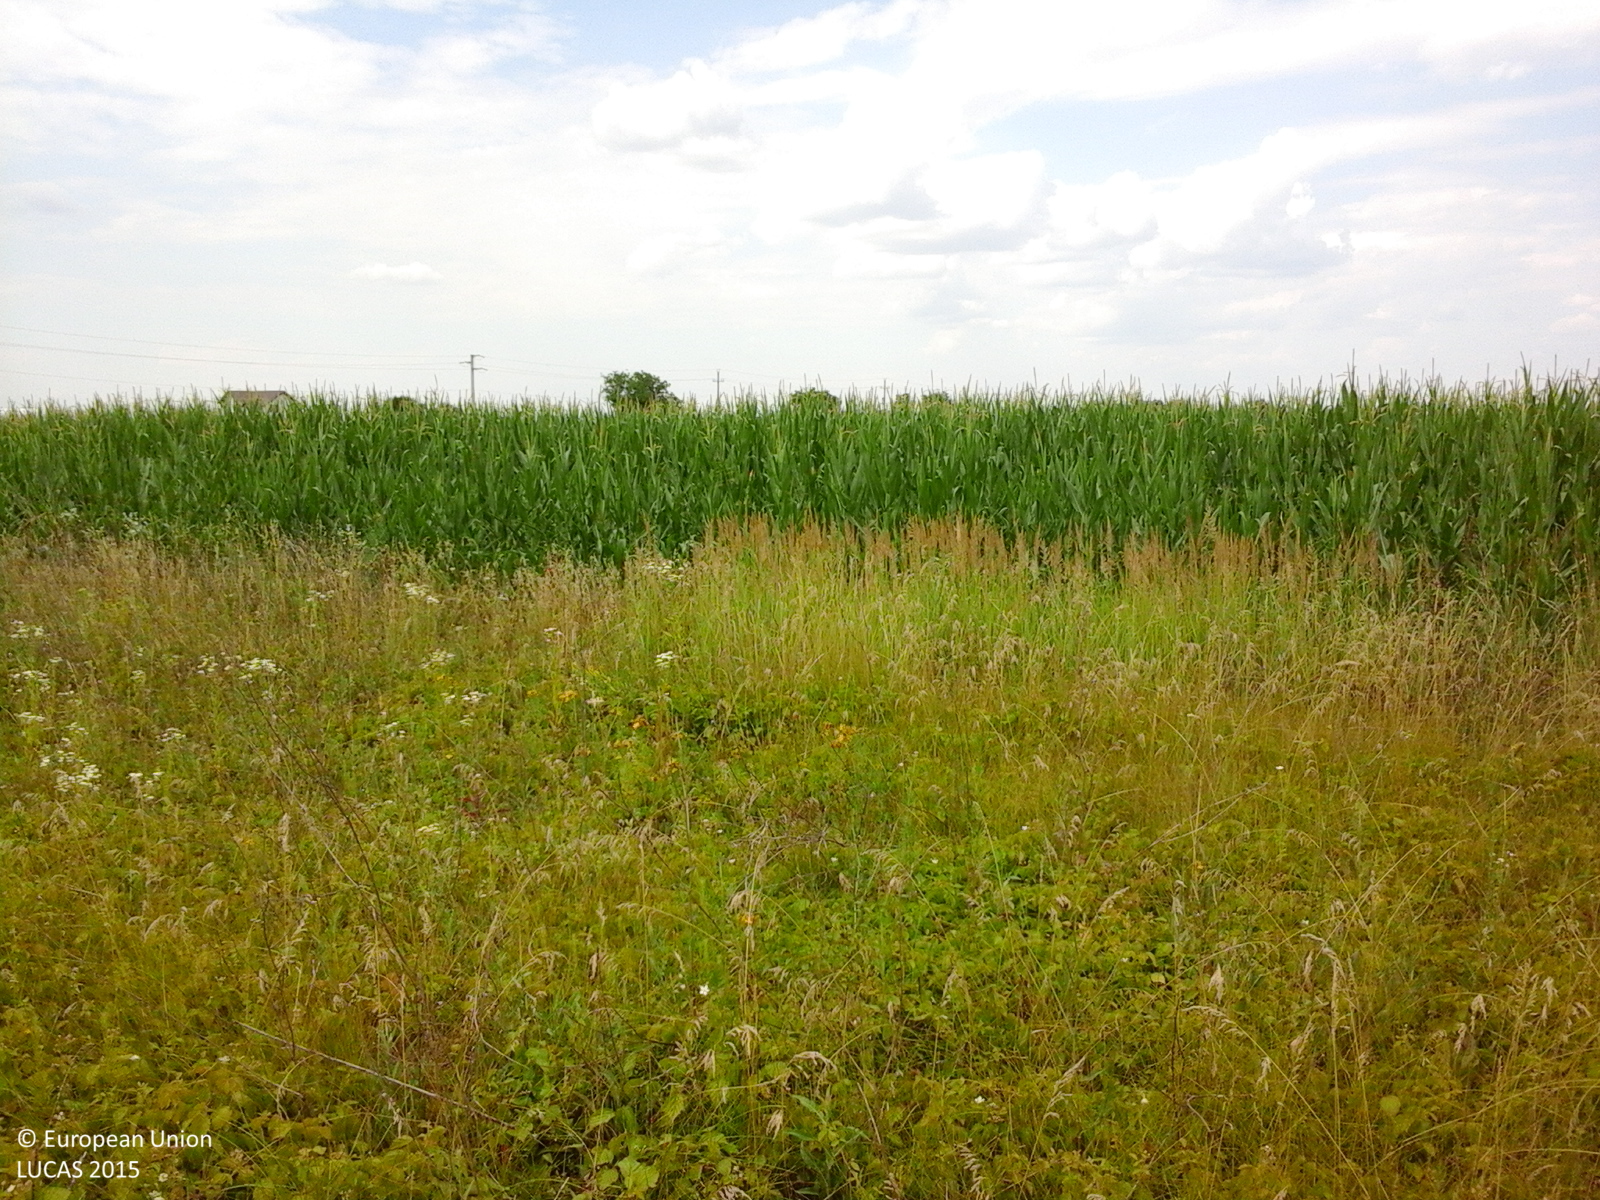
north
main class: Cropland
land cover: Sunflower
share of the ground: > 75 %
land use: Agriculture (excluding fallow land and kitchen gardens)
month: June
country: RO
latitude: 44.2824
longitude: 26.1821
